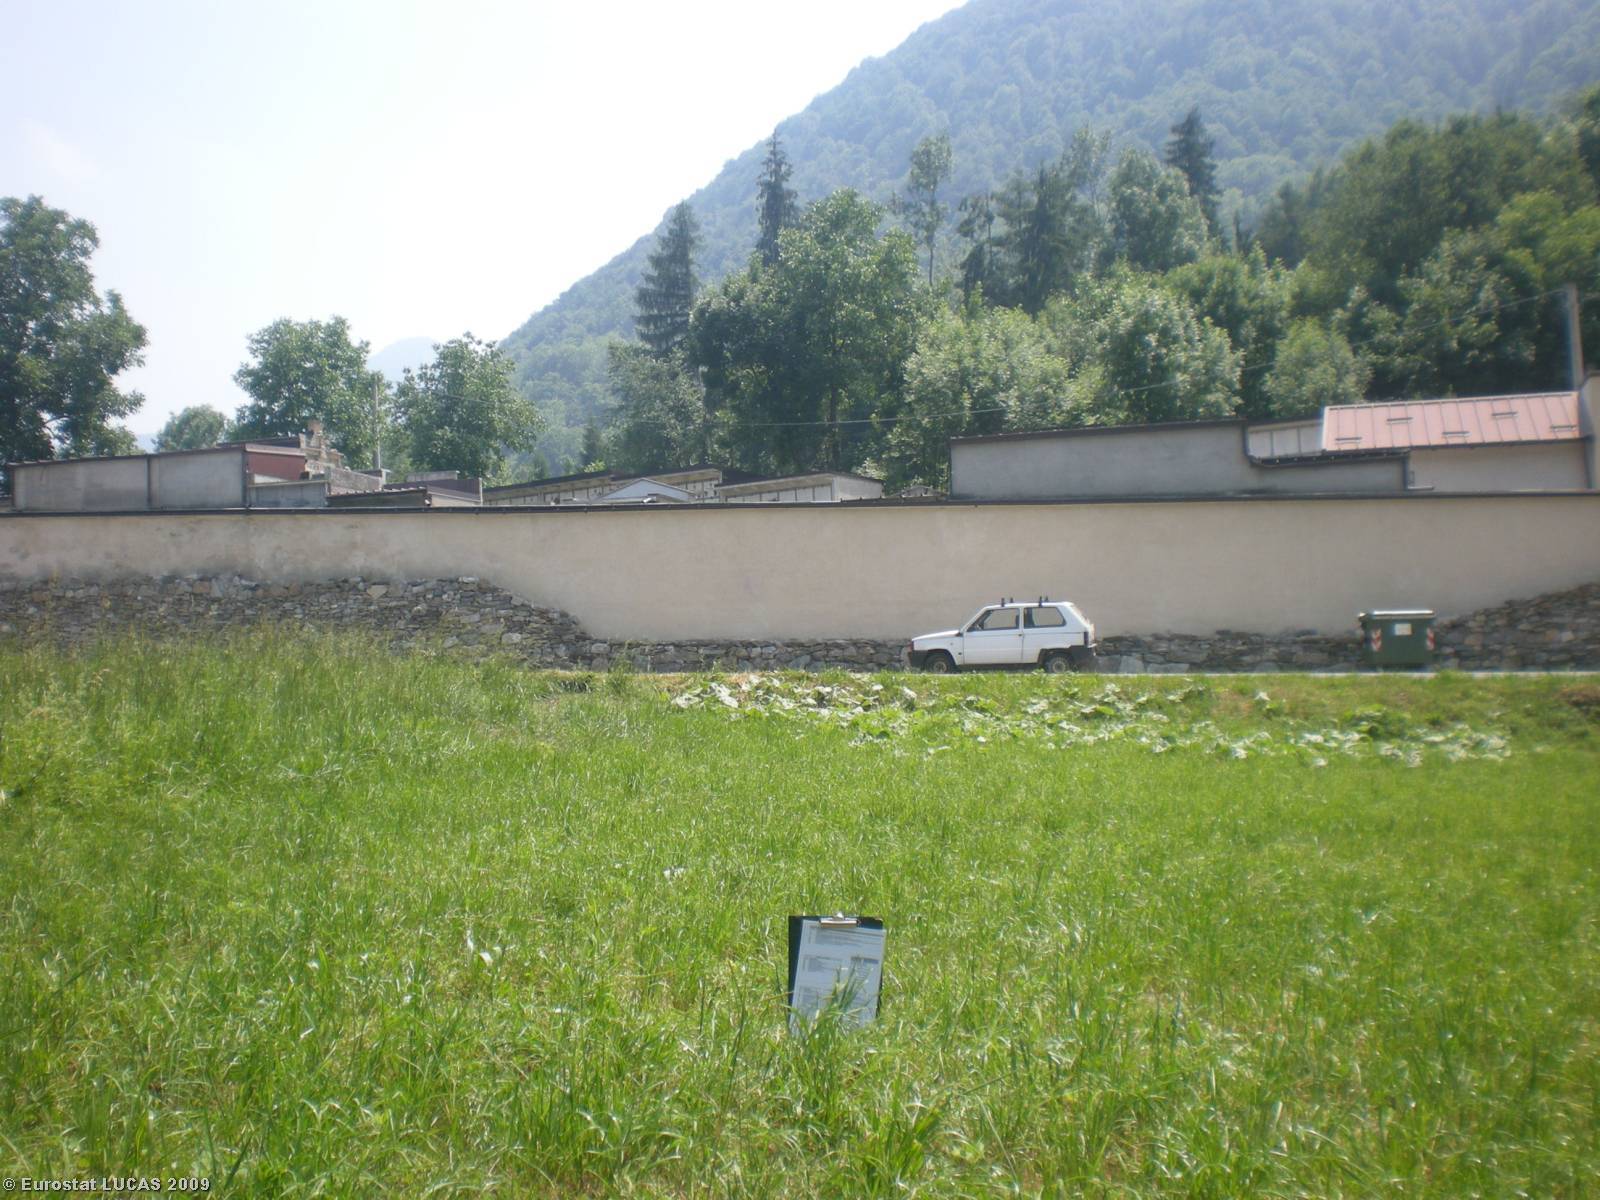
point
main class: Grassland
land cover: Grassland without tree/shrub cover
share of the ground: > 75 %
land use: Agriculture (excluding fallow land and kitchen gardens)
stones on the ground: < 10 %
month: June
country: IT
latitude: 44.3357
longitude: 7.3843
